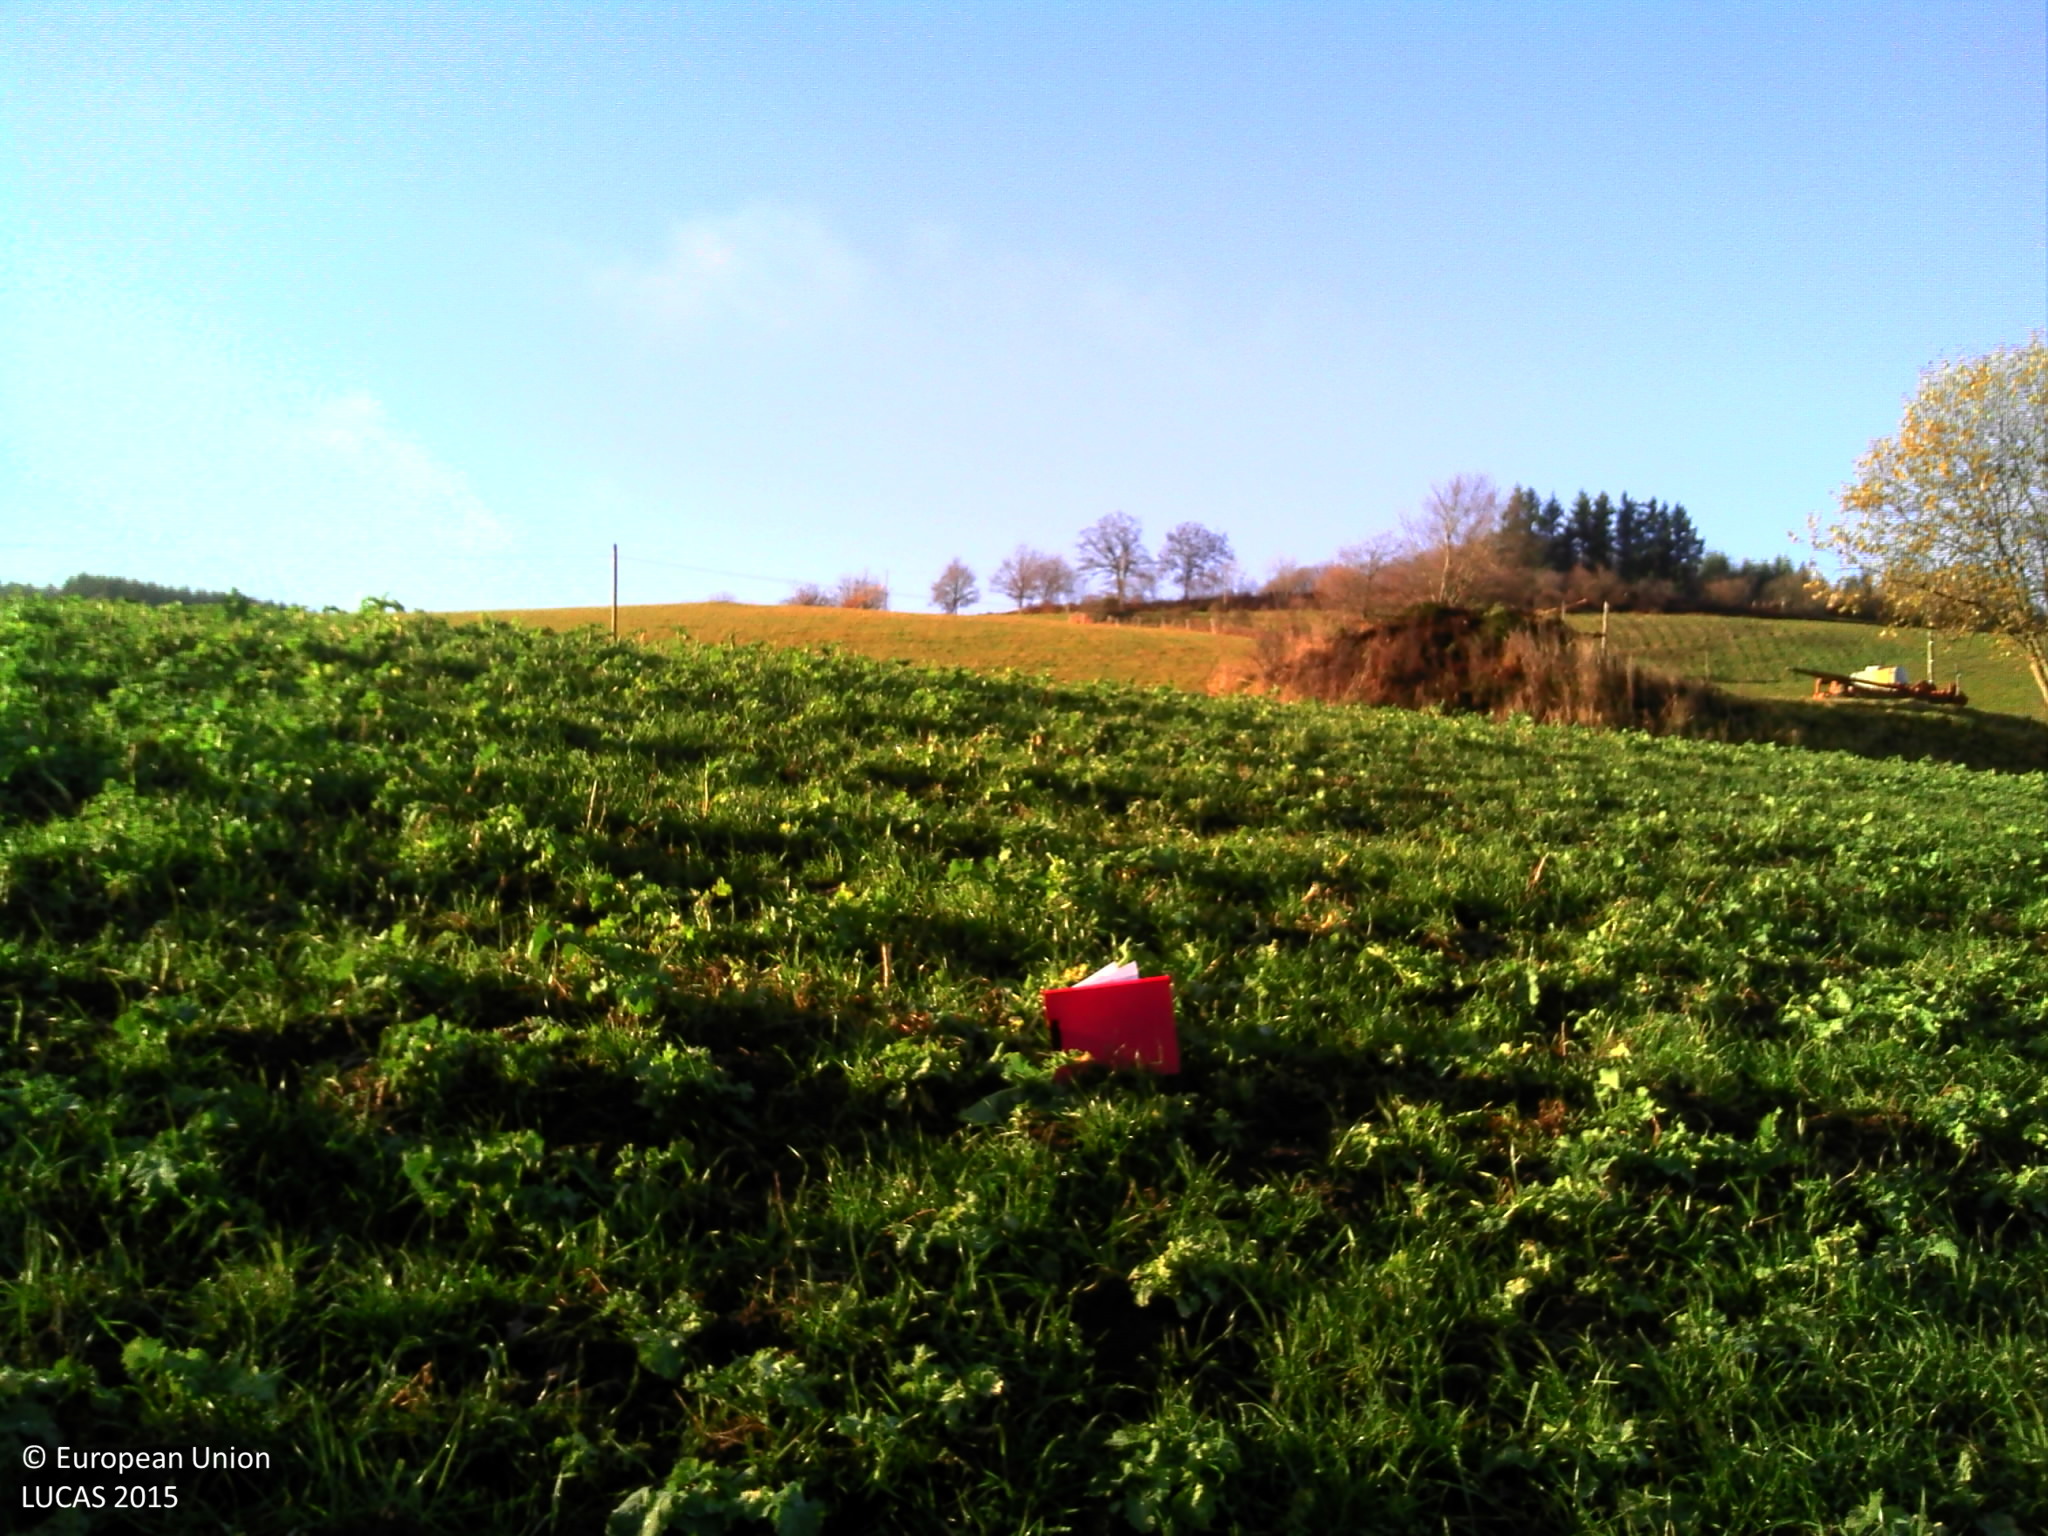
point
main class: Cropland
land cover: Rape and turnip rape
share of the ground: > 75 %
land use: Agriculture (excluding fallow land and kitchen gardens)
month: December
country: FR
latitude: 45.5588
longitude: 4.4821
